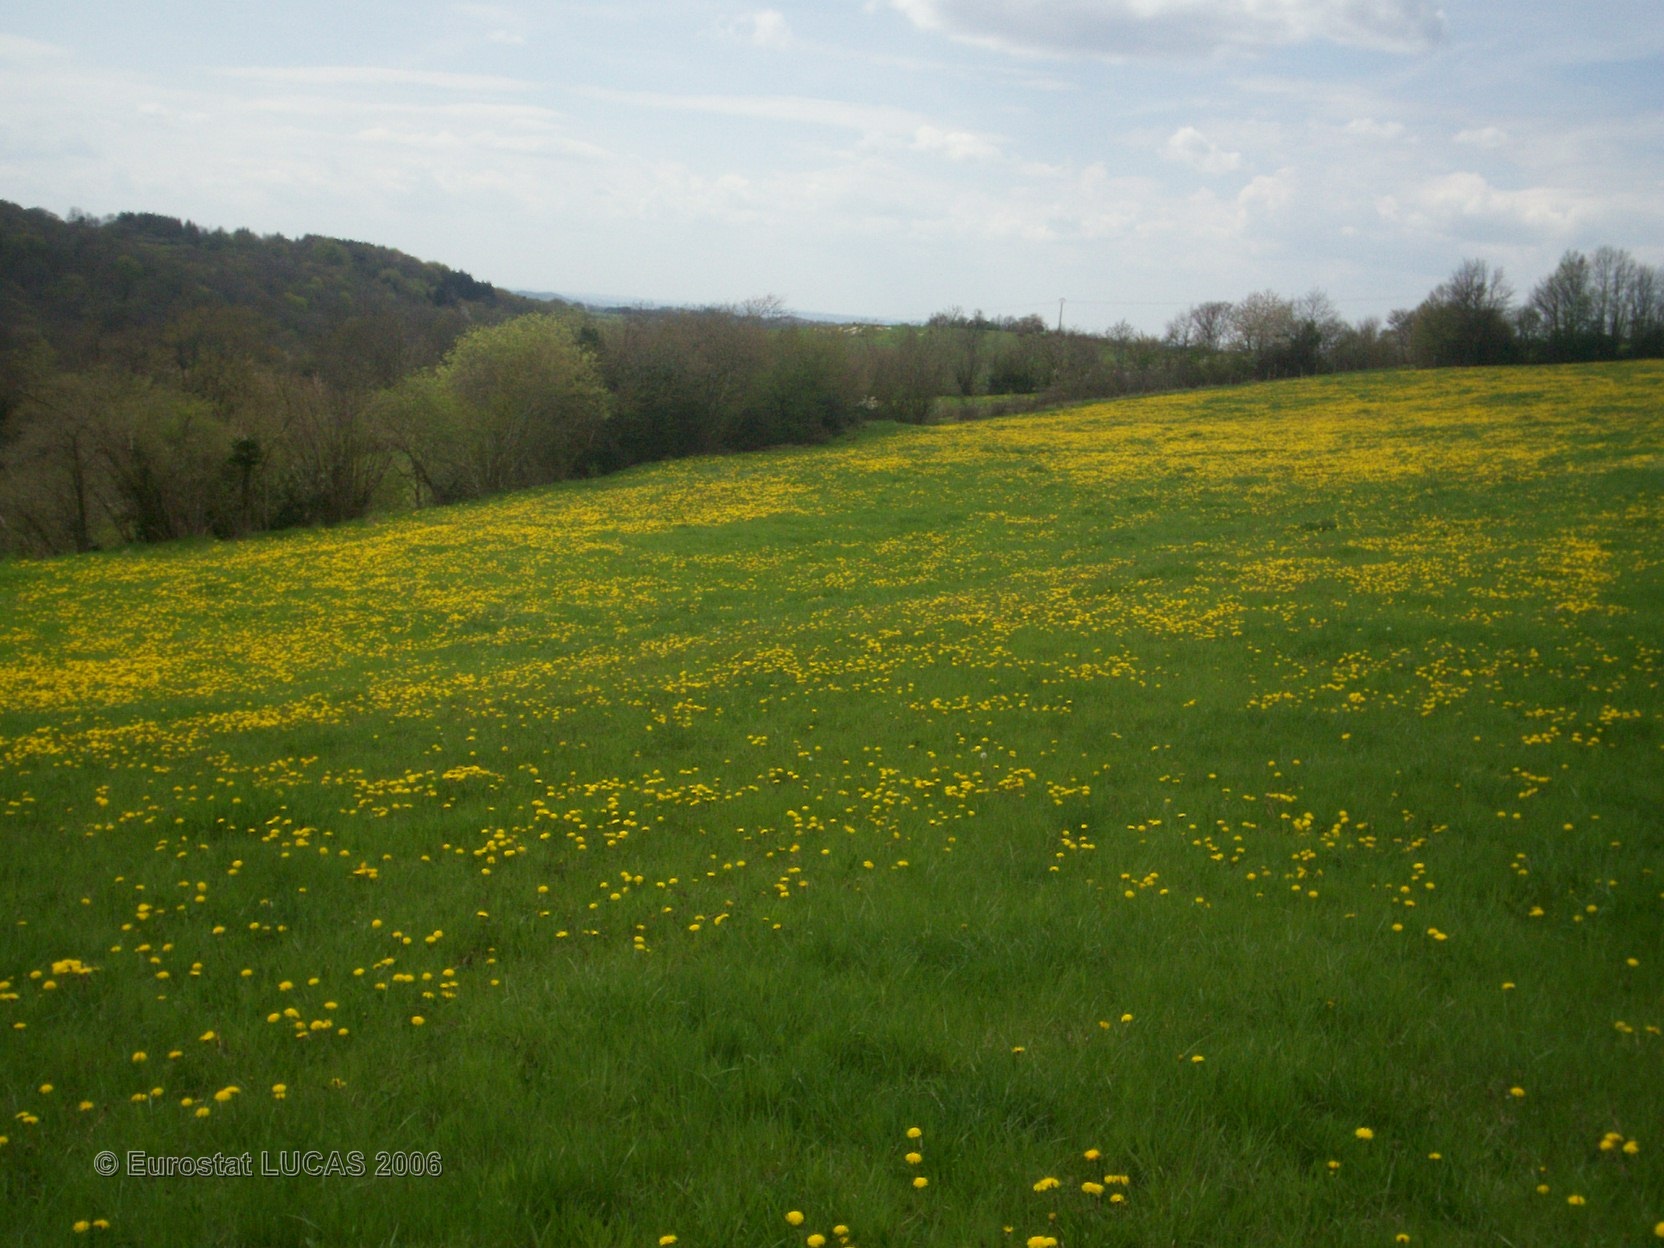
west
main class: Grassland
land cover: Grassland without tree/shrub cover
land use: Agriculture (excluding fallow land and kitchen gardens)
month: May
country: FR
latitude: 45.9355
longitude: 2.9179
